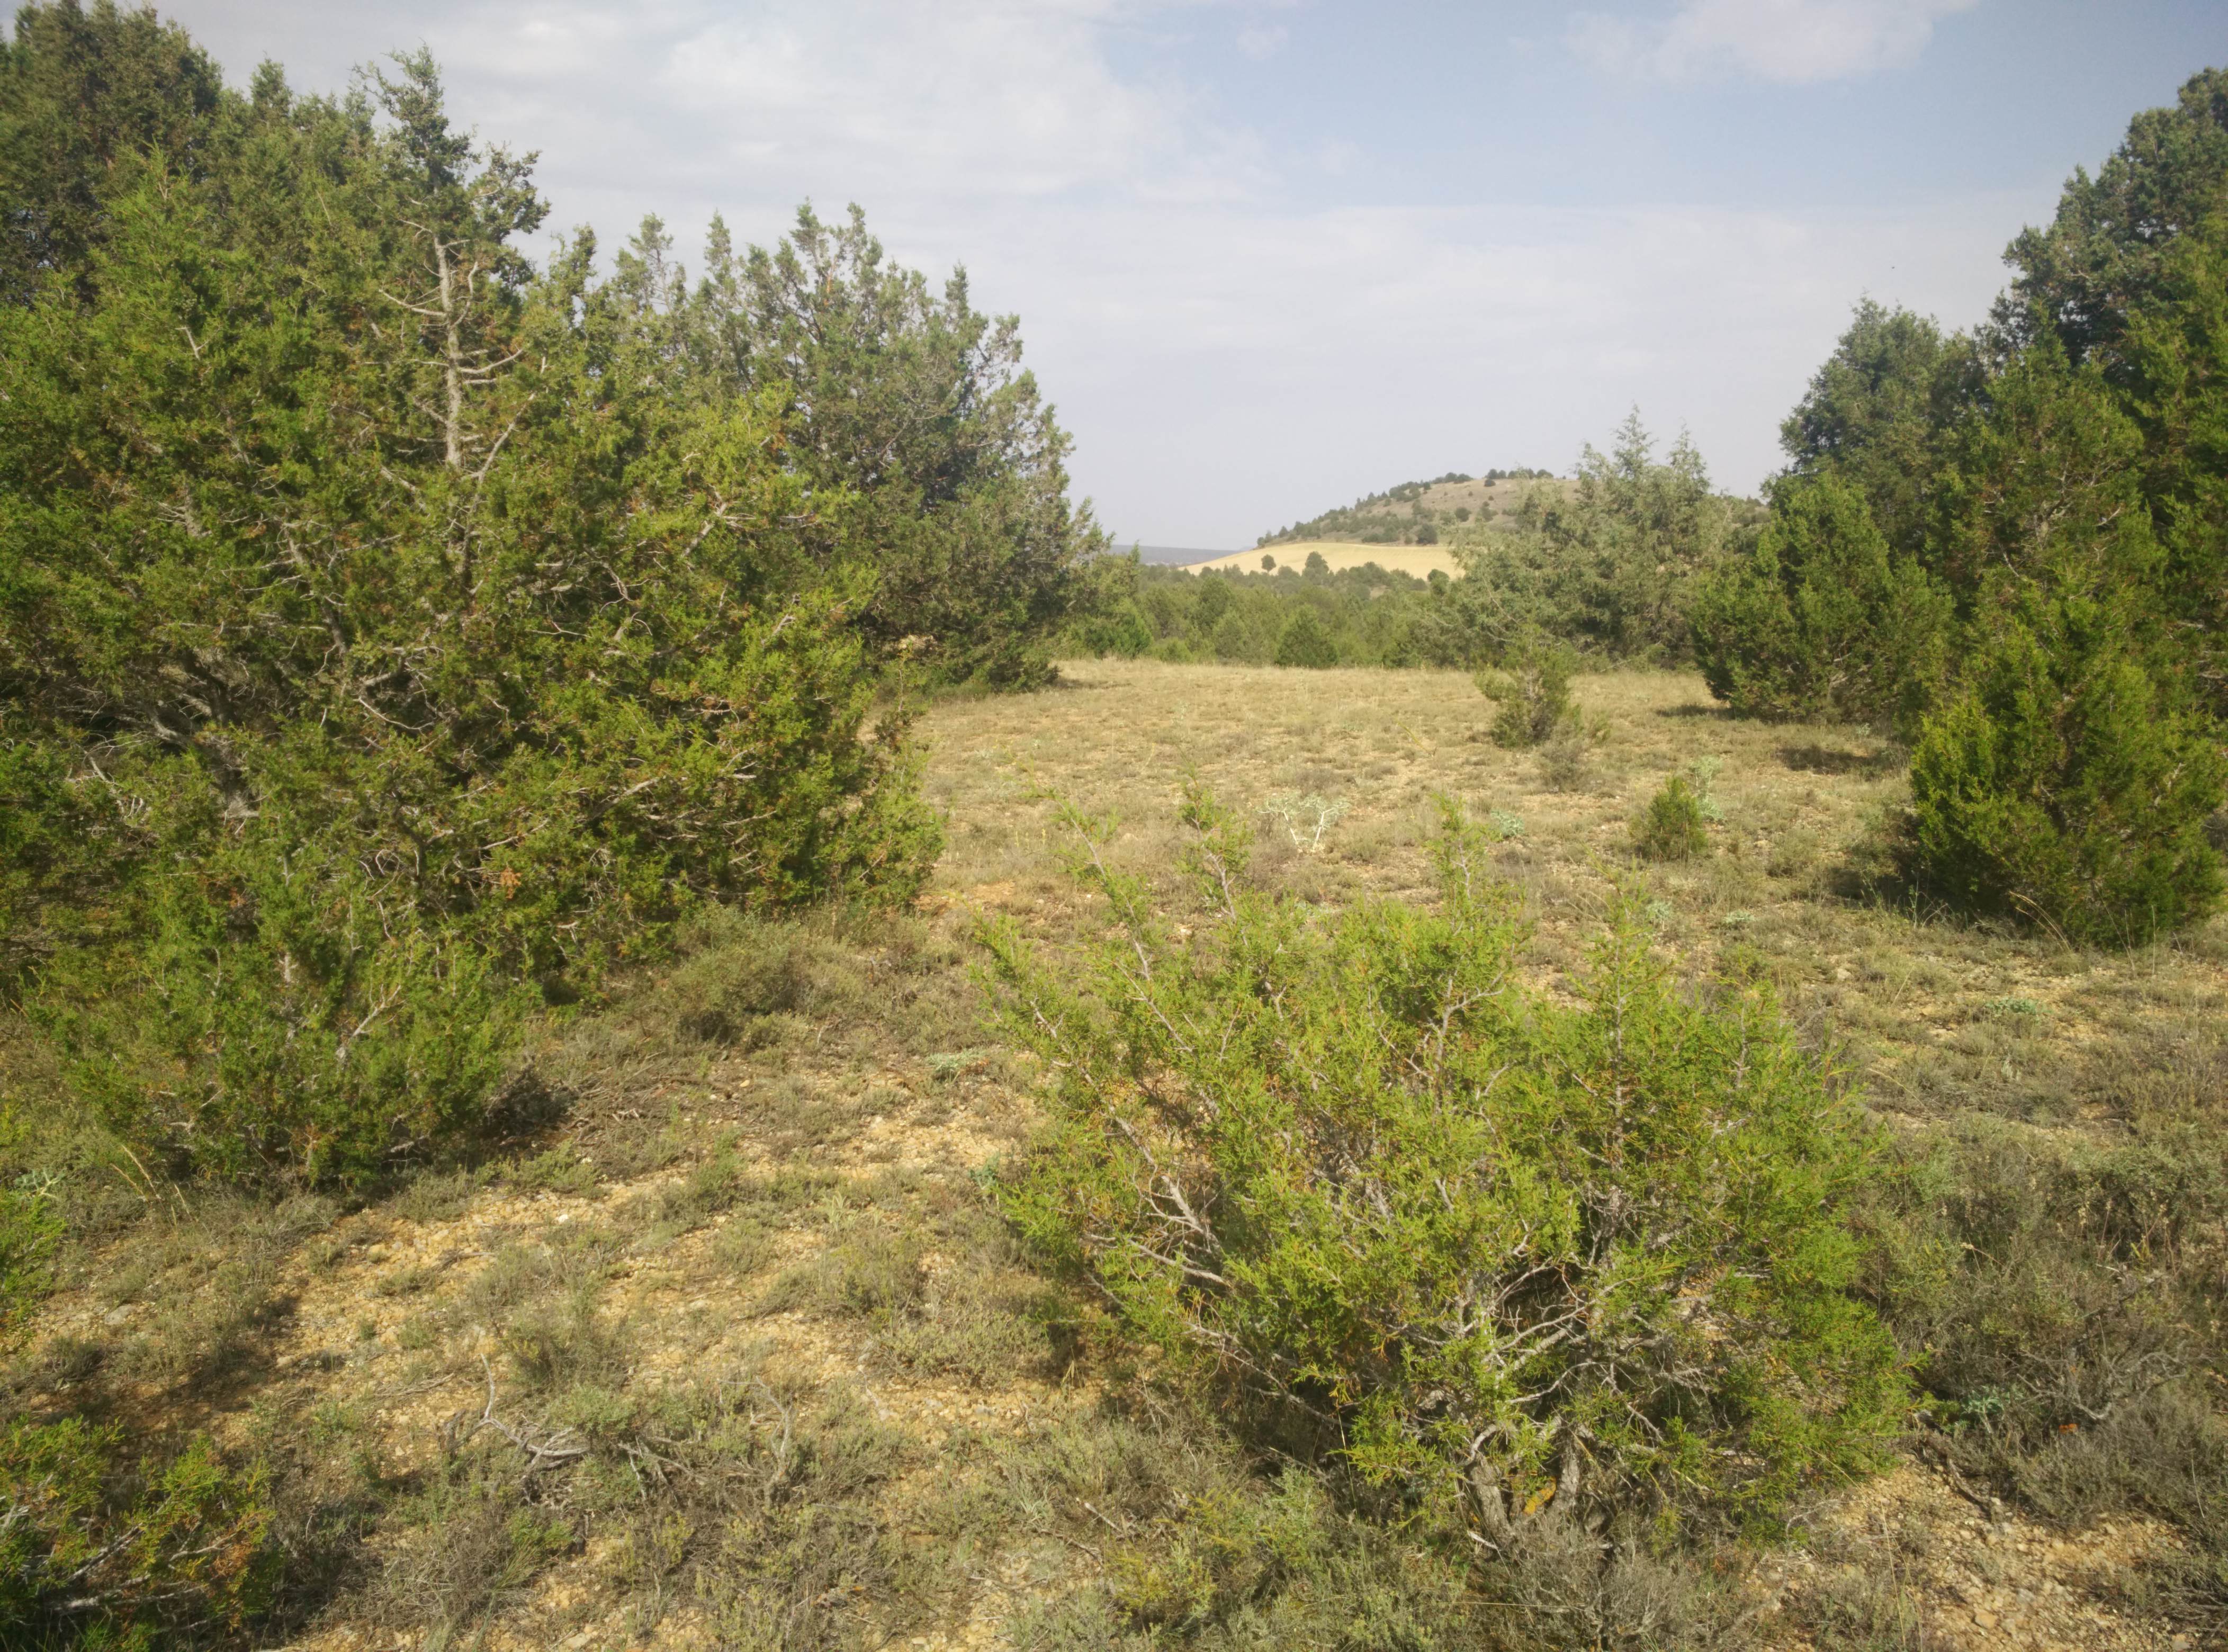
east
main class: Woodland
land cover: Other coniferous woodland
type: coniferous forest of the mediterranean region
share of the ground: 10 - 25 %
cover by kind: unconsolidated bare surface 50 %, shrubs 25 %, coniferous forest trees 20 %, herbaceous plants 5 %
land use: Semi-natural and natural areas not in use
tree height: > 5 m
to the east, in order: Other coniferous woodland; Sunflower; Grass margins; Tracks; Grass margins; Other coniferous woodland
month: July
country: ES
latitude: 41.0495
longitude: -2.1023
